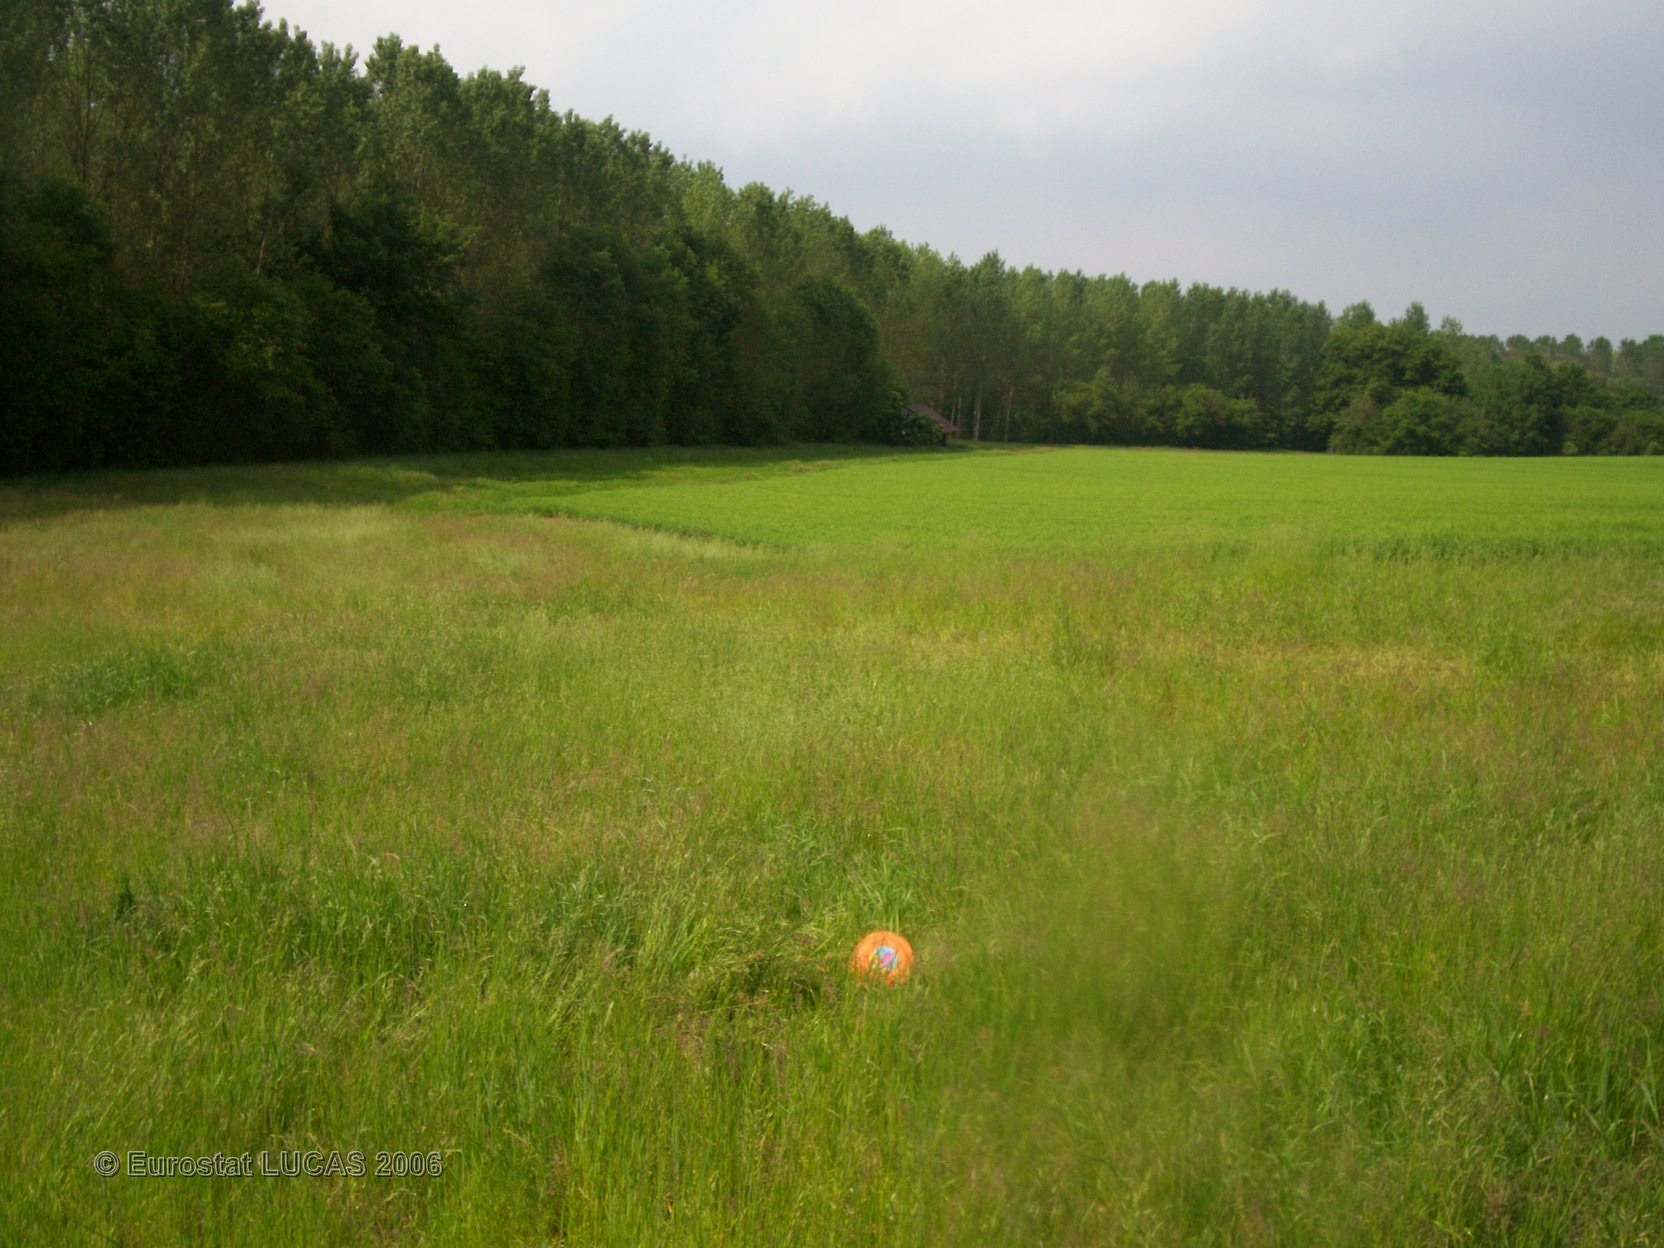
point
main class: Grassland
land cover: Grassland without tree/shrub cover
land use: Agriculture (excluding fallow land and kitchen gardens)
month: June
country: FR
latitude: 49.6962
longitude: 2.6827
